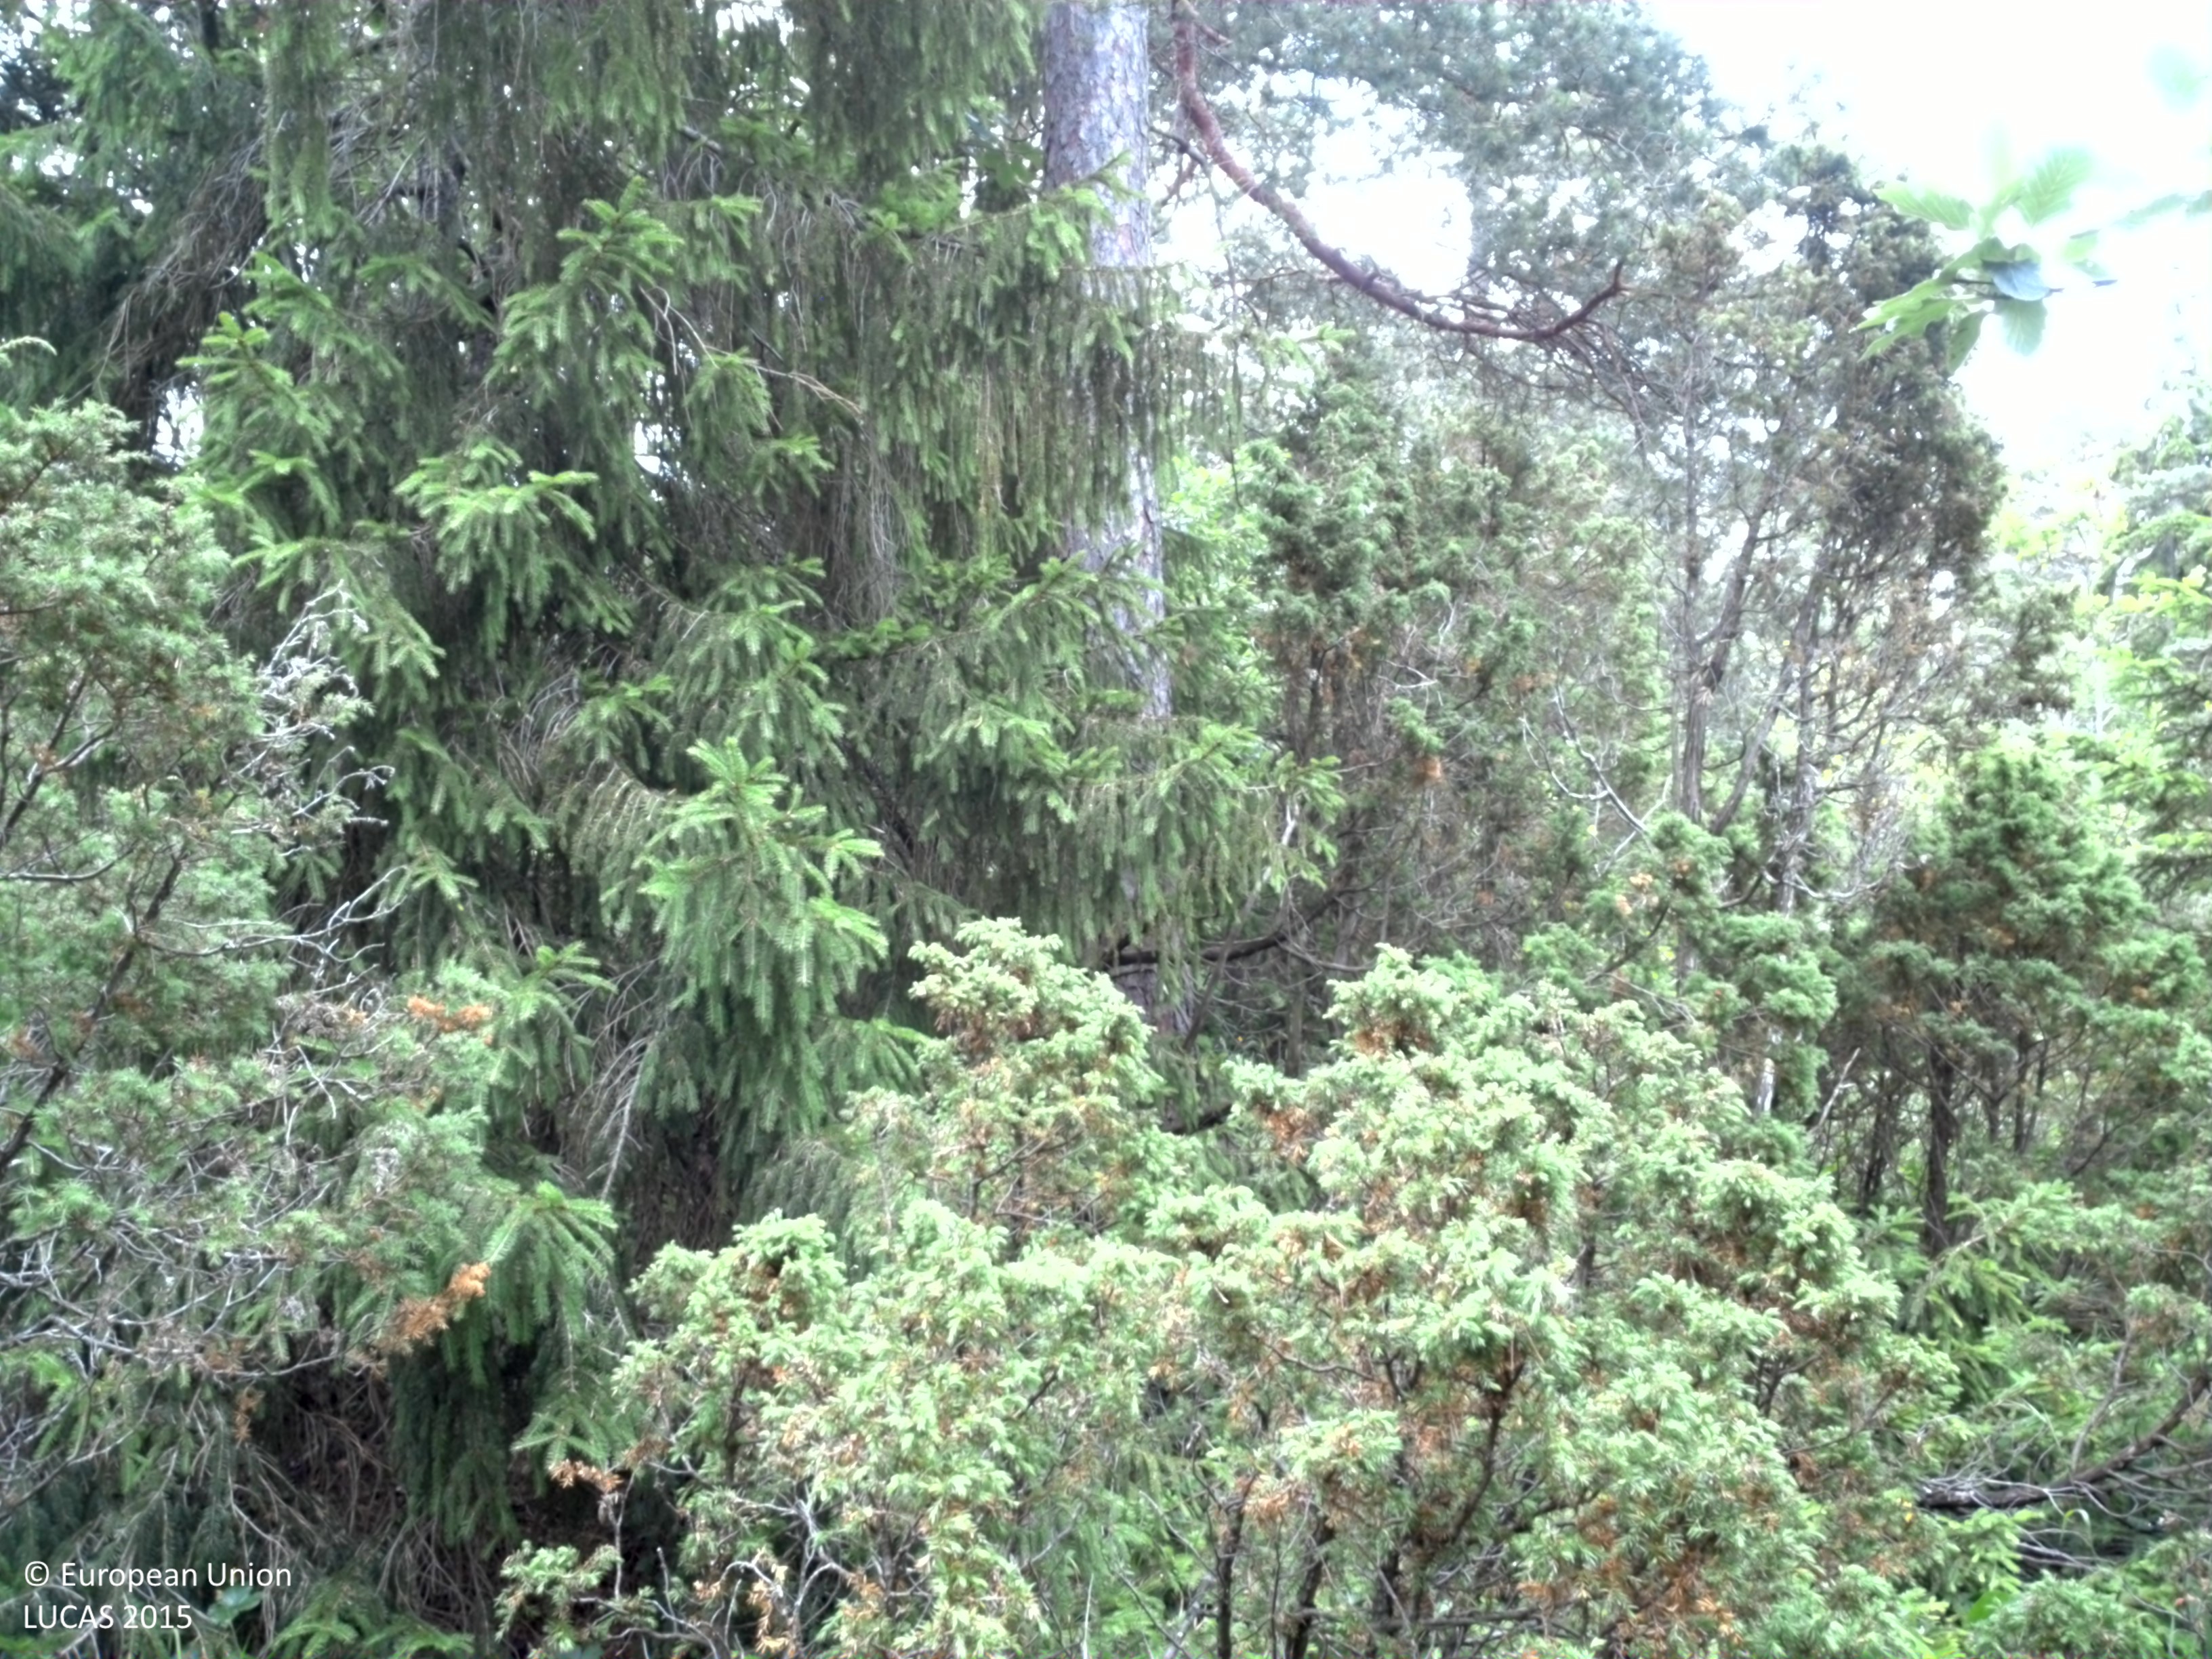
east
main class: Woodland
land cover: Other mixed woodland
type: hemiboreal forest and nemoral coniferous forest and mixed broadleaved-coniferous forest
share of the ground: > 75 %
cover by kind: coniferous forest trees 50 %, broadleaved forest trees 20 %, herbaceous plants 20 %, shrubs 10 %
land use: Forestry
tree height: > 5 m
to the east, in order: Other mixed woodland; Pine dominated mixed woodland; Other mixed woodland
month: July
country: SE
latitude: 57.3695
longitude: 18.2383
